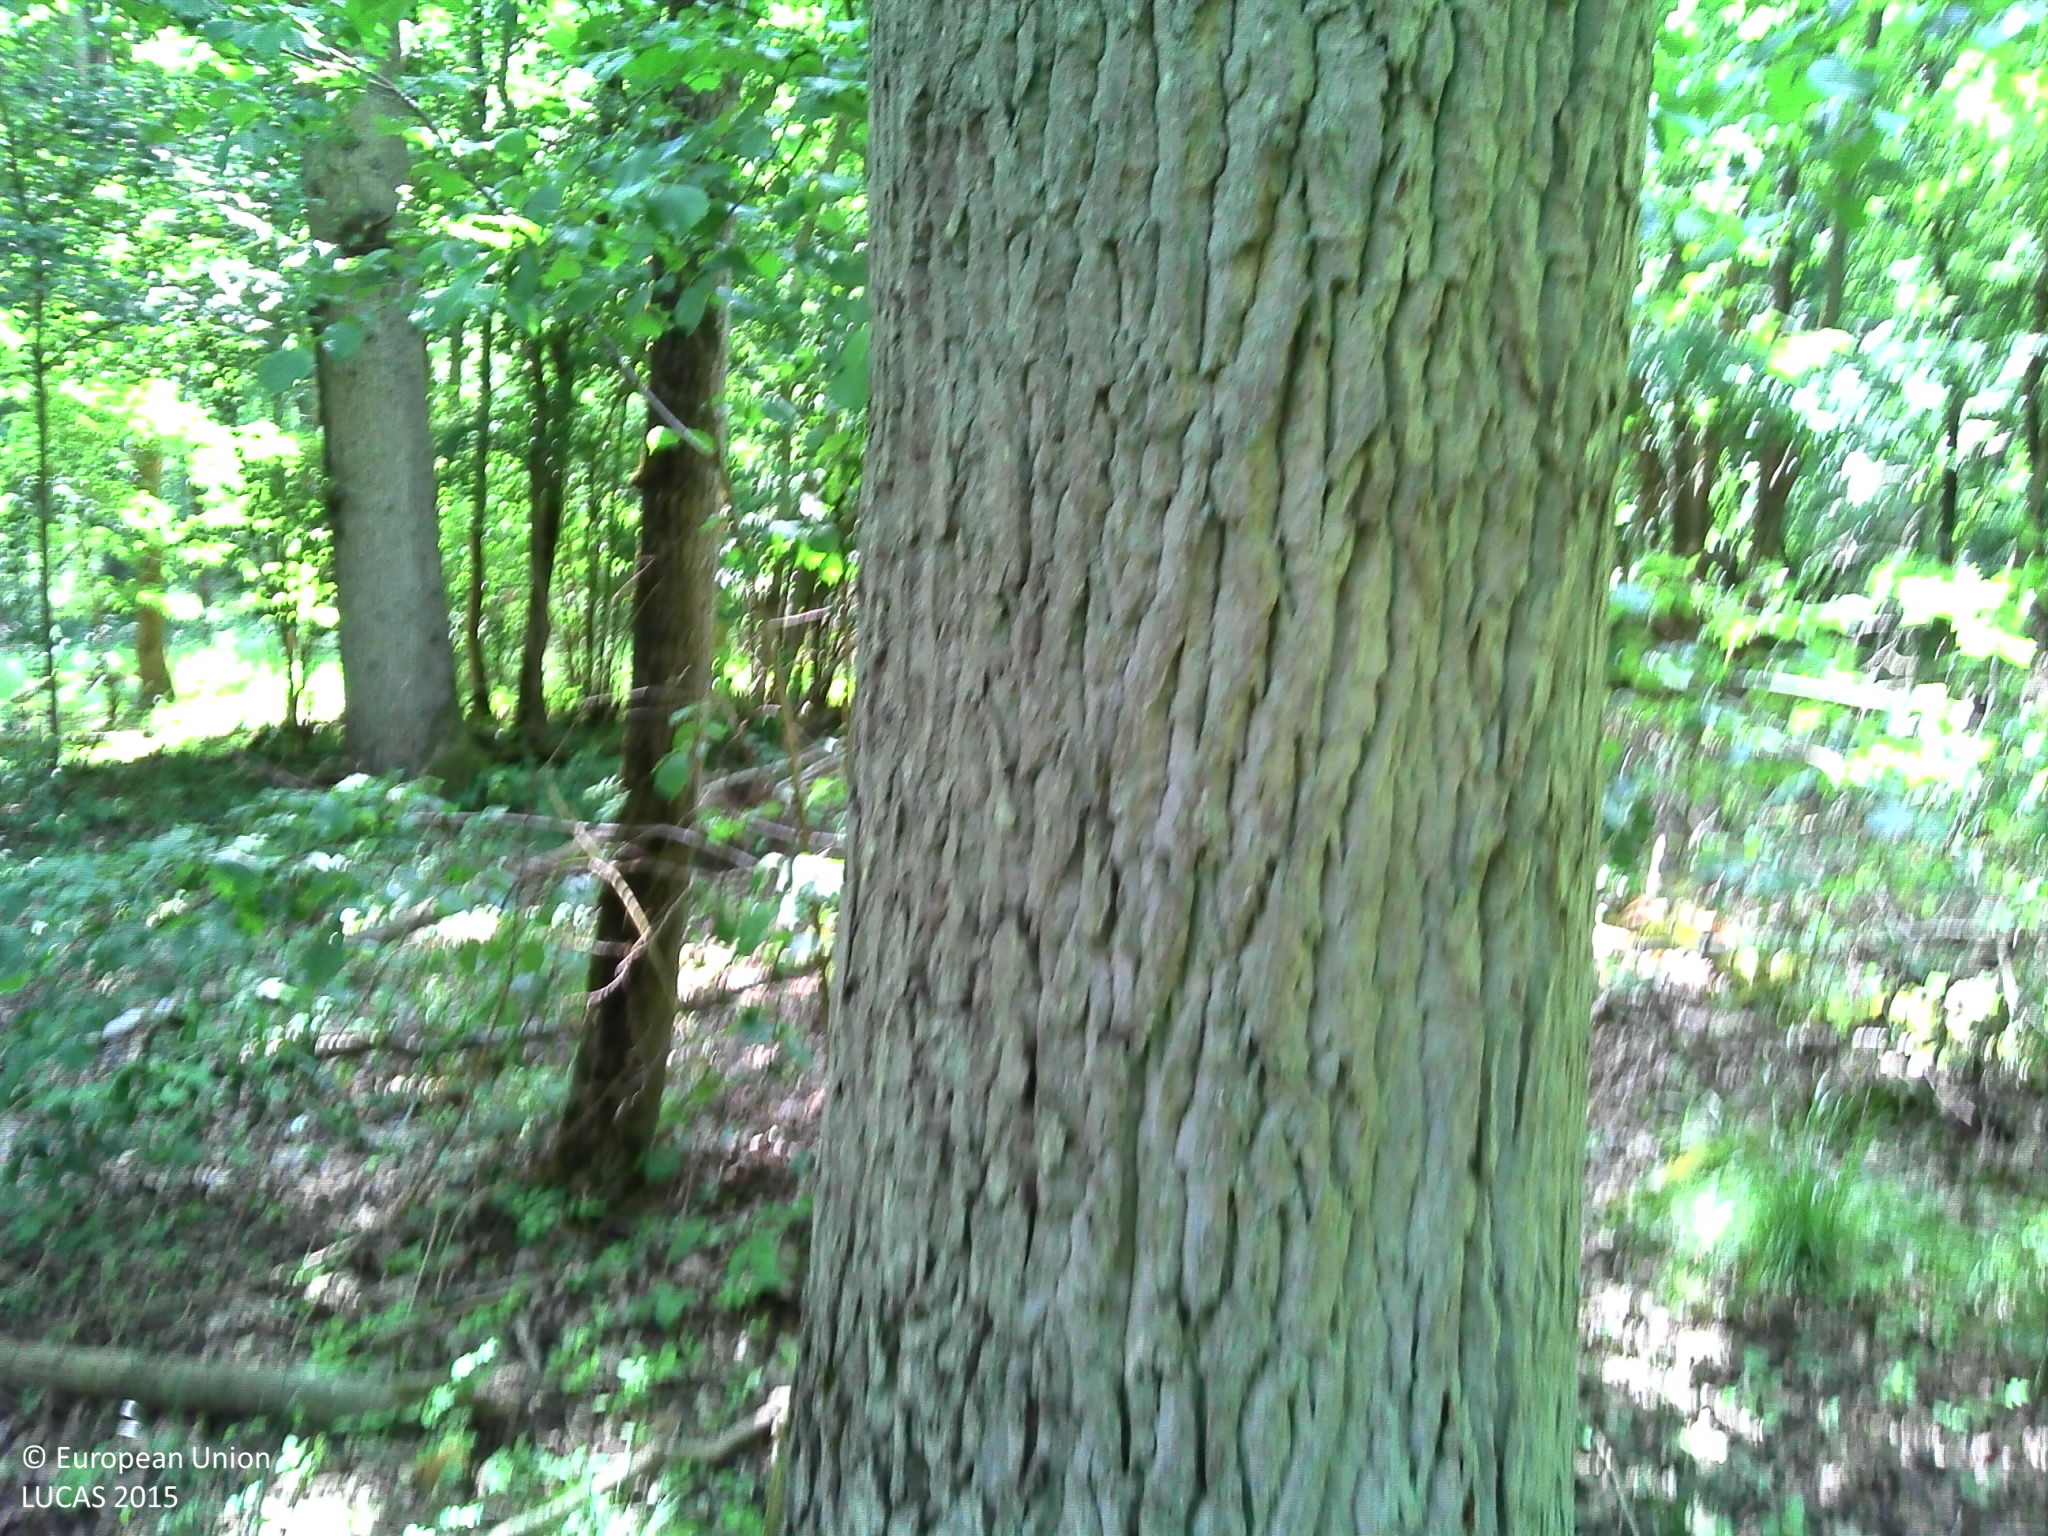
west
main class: Woodland
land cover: Broadleaved woodland
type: mesophytic deciduous forest
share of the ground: > 75 %
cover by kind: broadleaved forest trees 80 %, herbaceous plants 10 %
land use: Forestry
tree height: > 5 m
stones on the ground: < 10 %
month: June
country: FR
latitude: 50.7595
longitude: 2.3738
